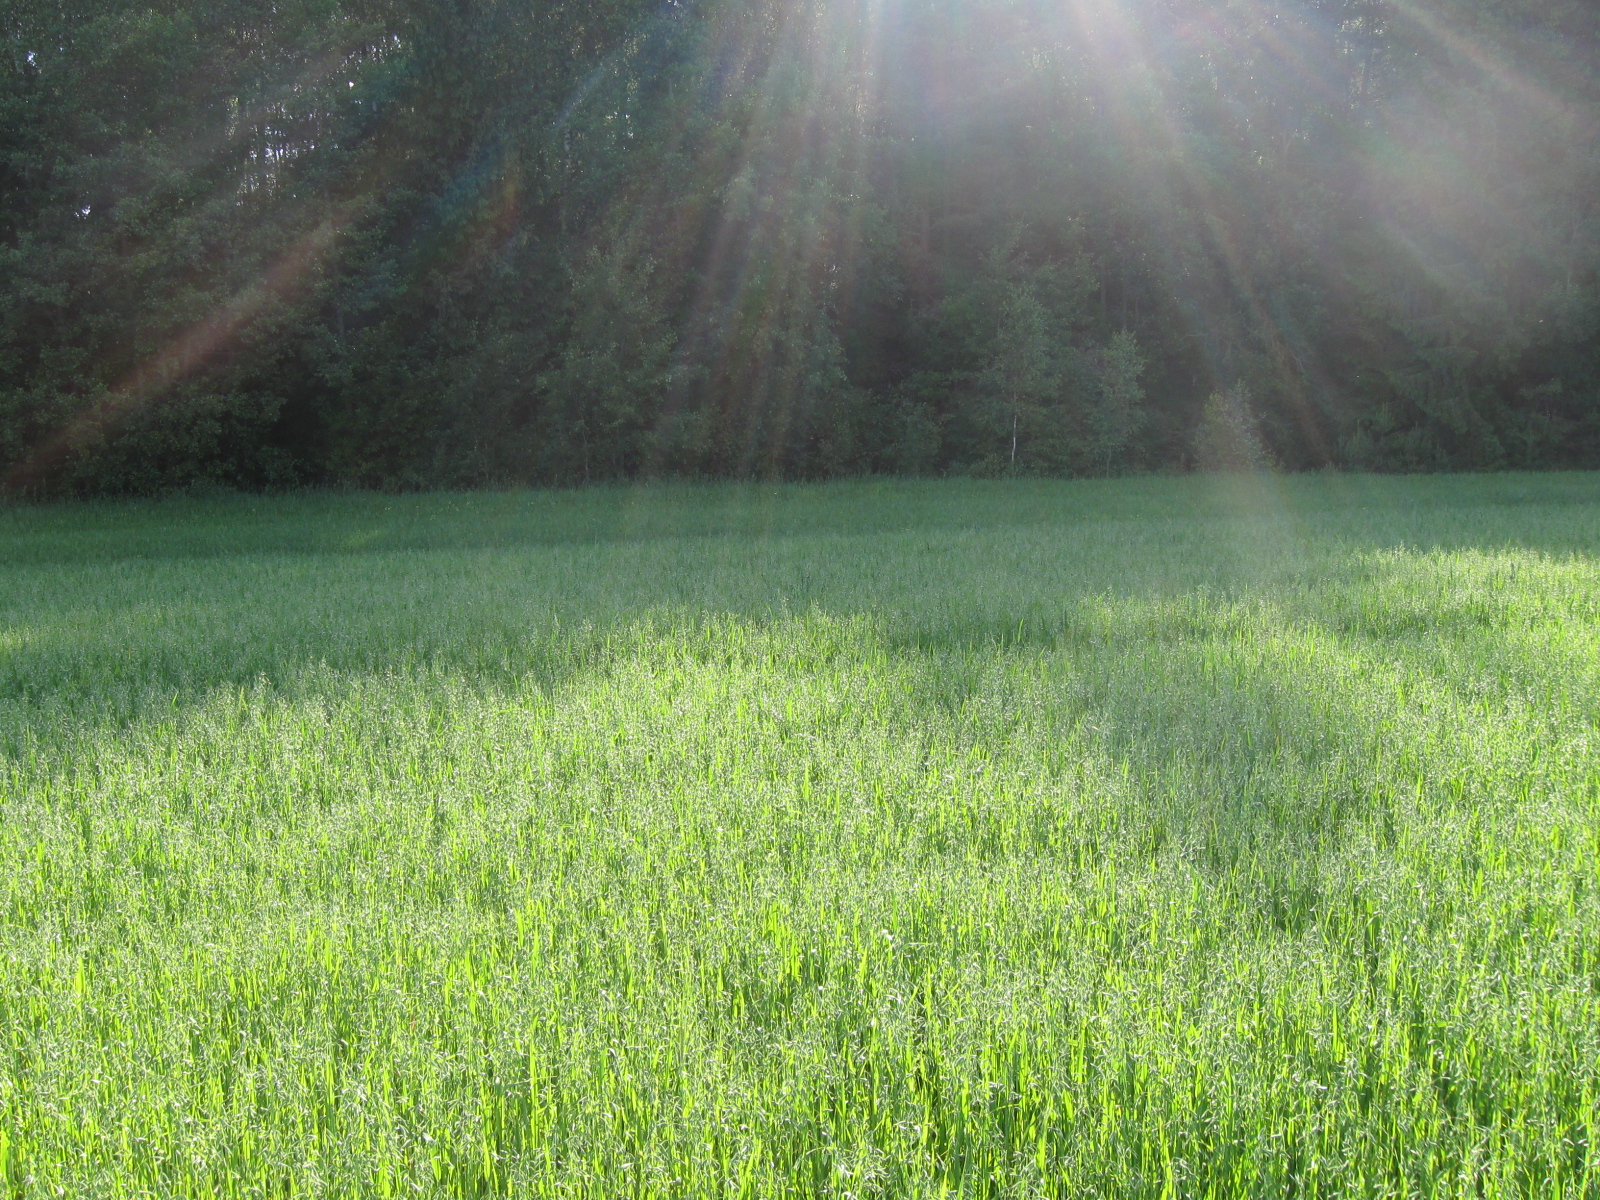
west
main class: Cropland
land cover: Oats
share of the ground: > 75 %
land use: Agriculture (excluding fallow land and kitchen gardens)
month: June
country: LT
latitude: 54.1727
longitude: 24.7704
